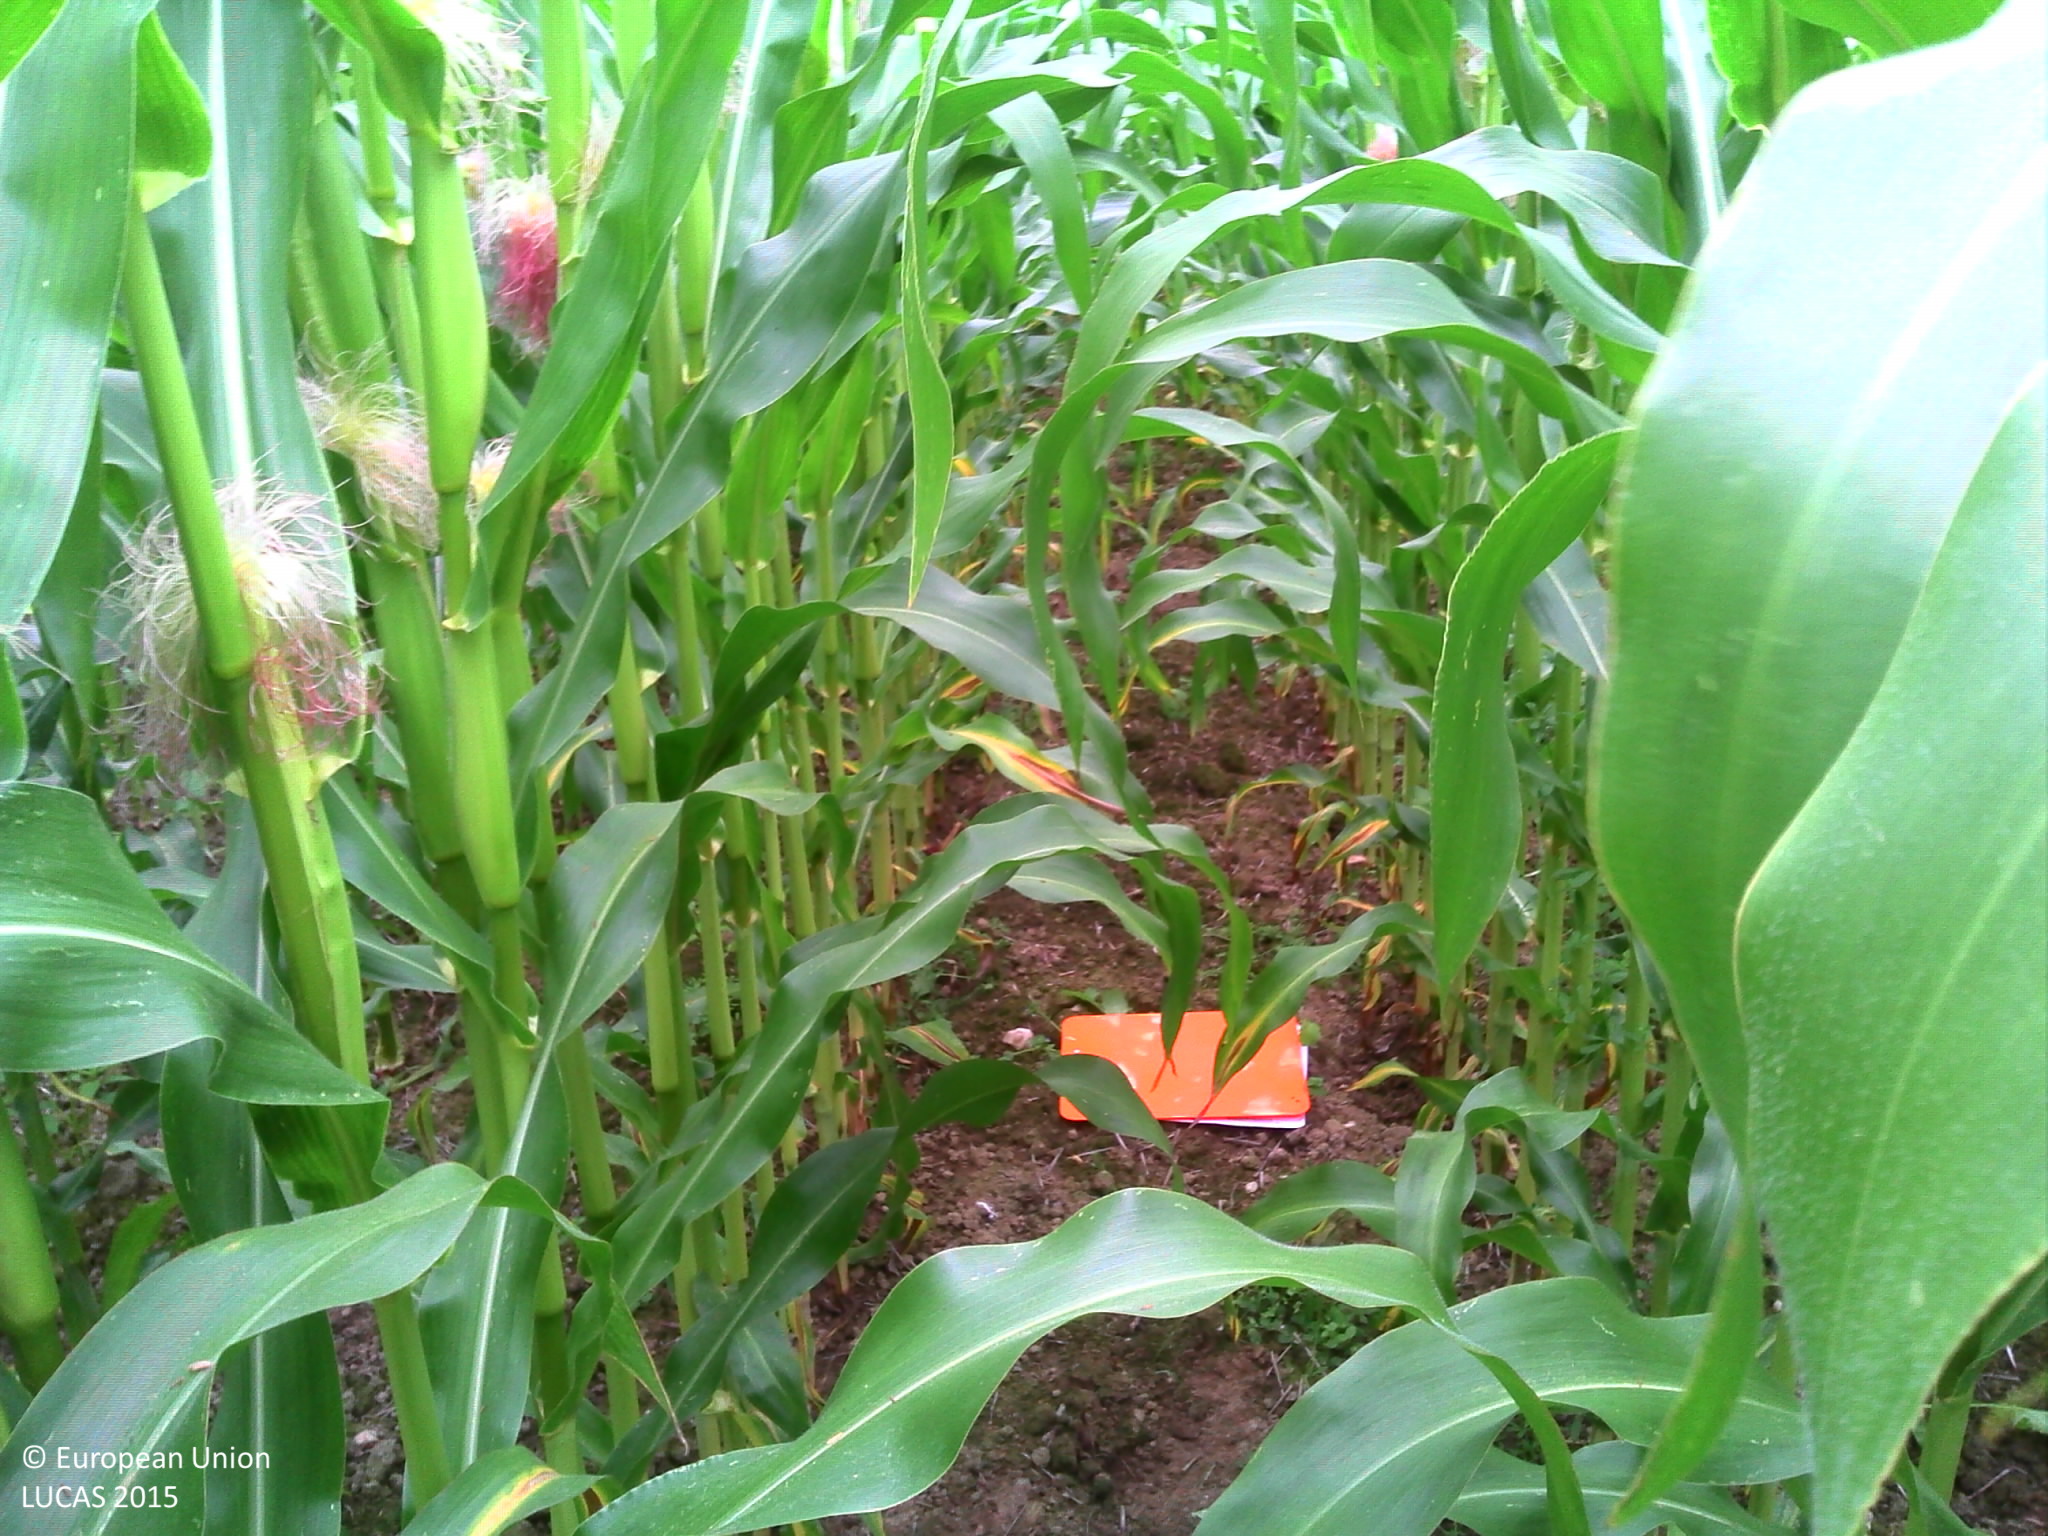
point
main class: Cropland
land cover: Maize
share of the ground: 50 - 75 %
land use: Agriculture (excluding fallow land and kitchen gardens)
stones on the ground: < 10 %
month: August
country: FR
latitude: 48.2616
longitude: -3.3711
